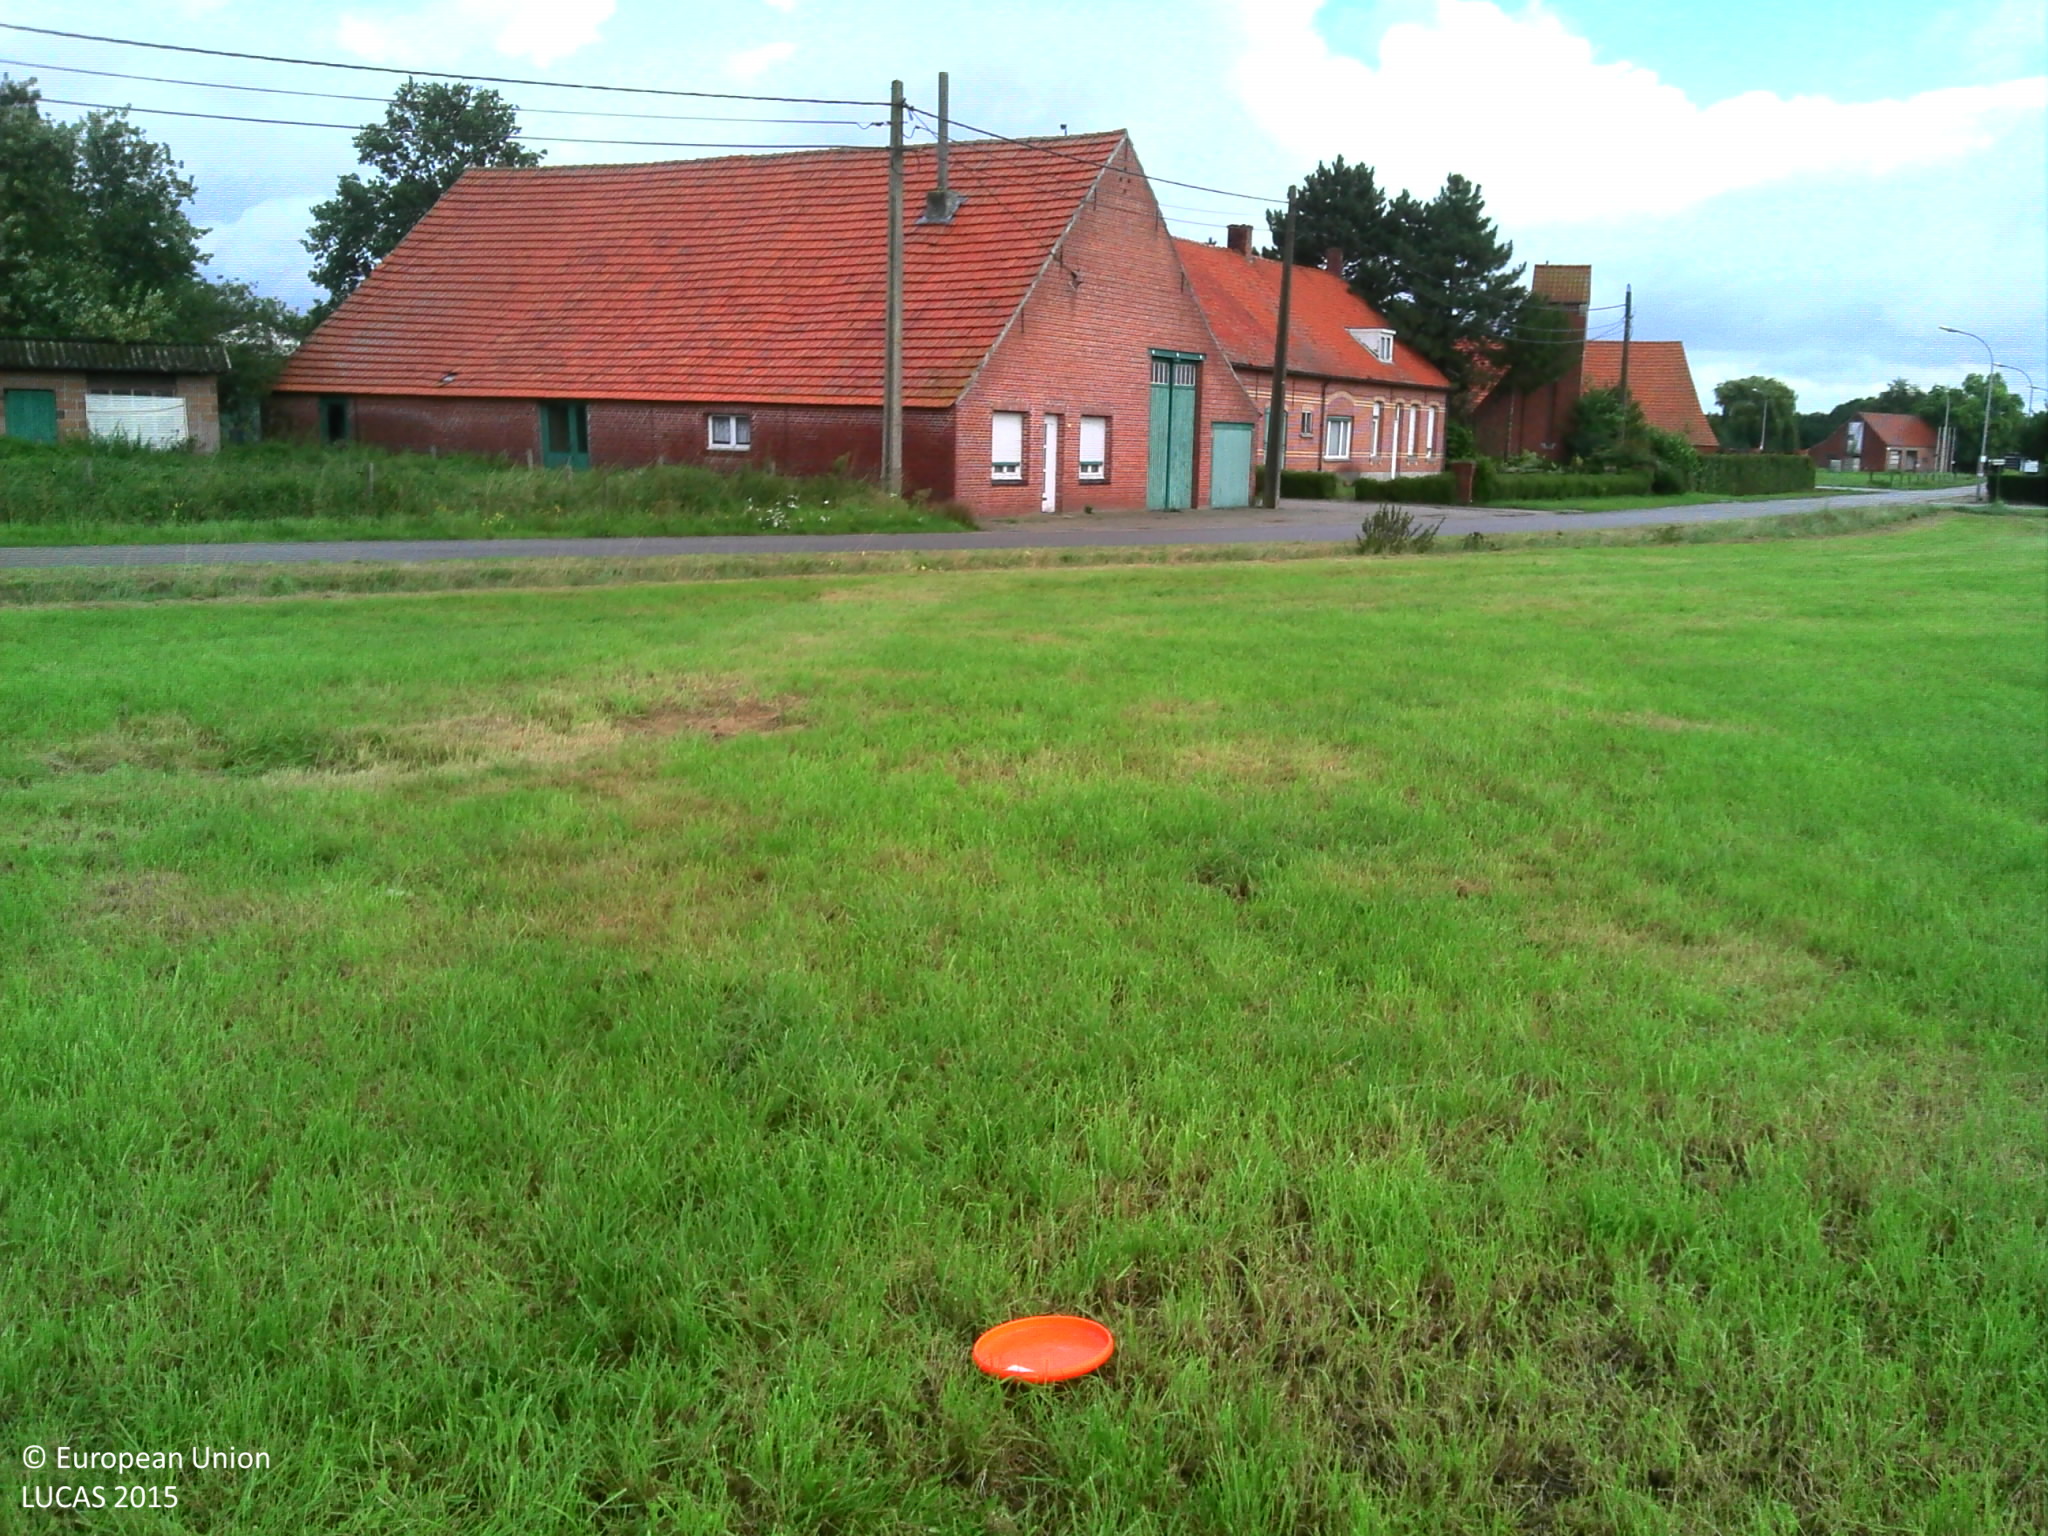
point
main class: Grassland
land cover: Grassland without tree/shrub cover
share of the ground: > 75 %
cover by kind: herbaceous plants 100 %
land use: Agriculture (excluding fallow land and kitchen gardens)
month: September
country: BE
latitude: 51.4325
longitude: 4.7462
